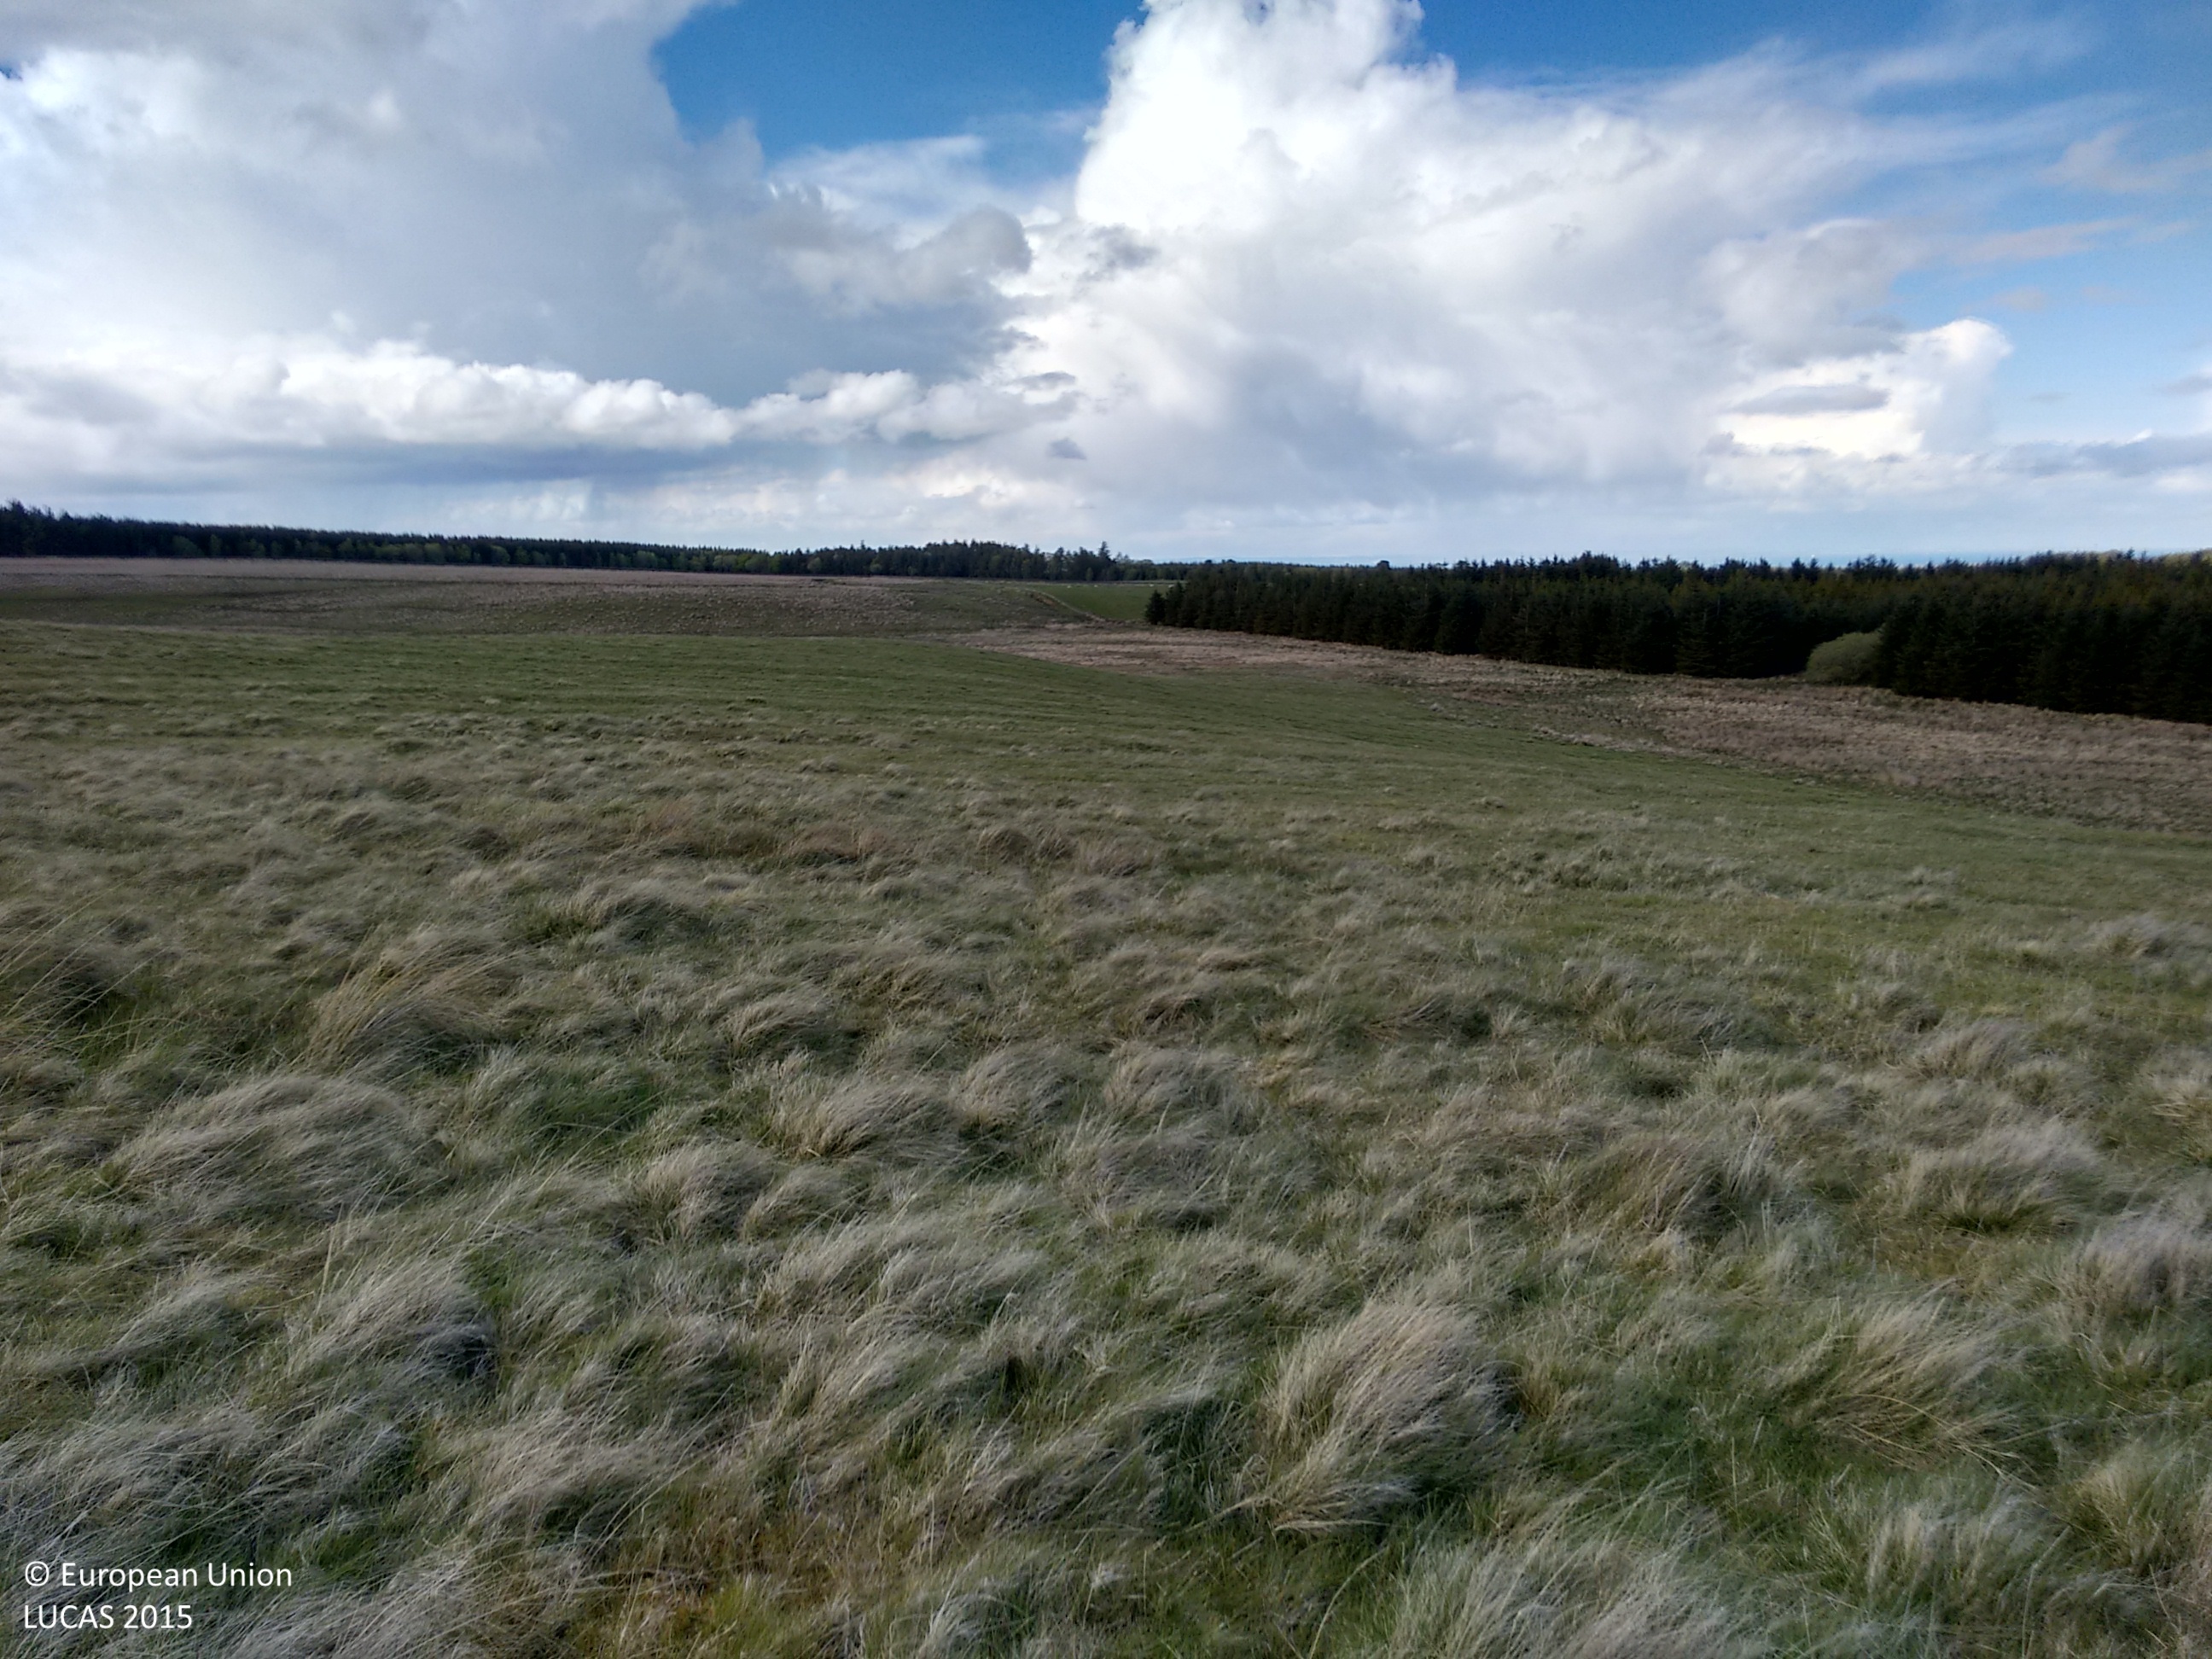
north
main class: Grassland
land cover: Grassland without tree/shrub cover
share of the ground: > 75 %
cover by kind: herbaceous plants 100 %
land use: Agriculture (excluding fallow land and kitchen gardens)
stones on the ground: < 10 %
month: May
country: GB
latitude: 55.8181
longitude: -3.1422
